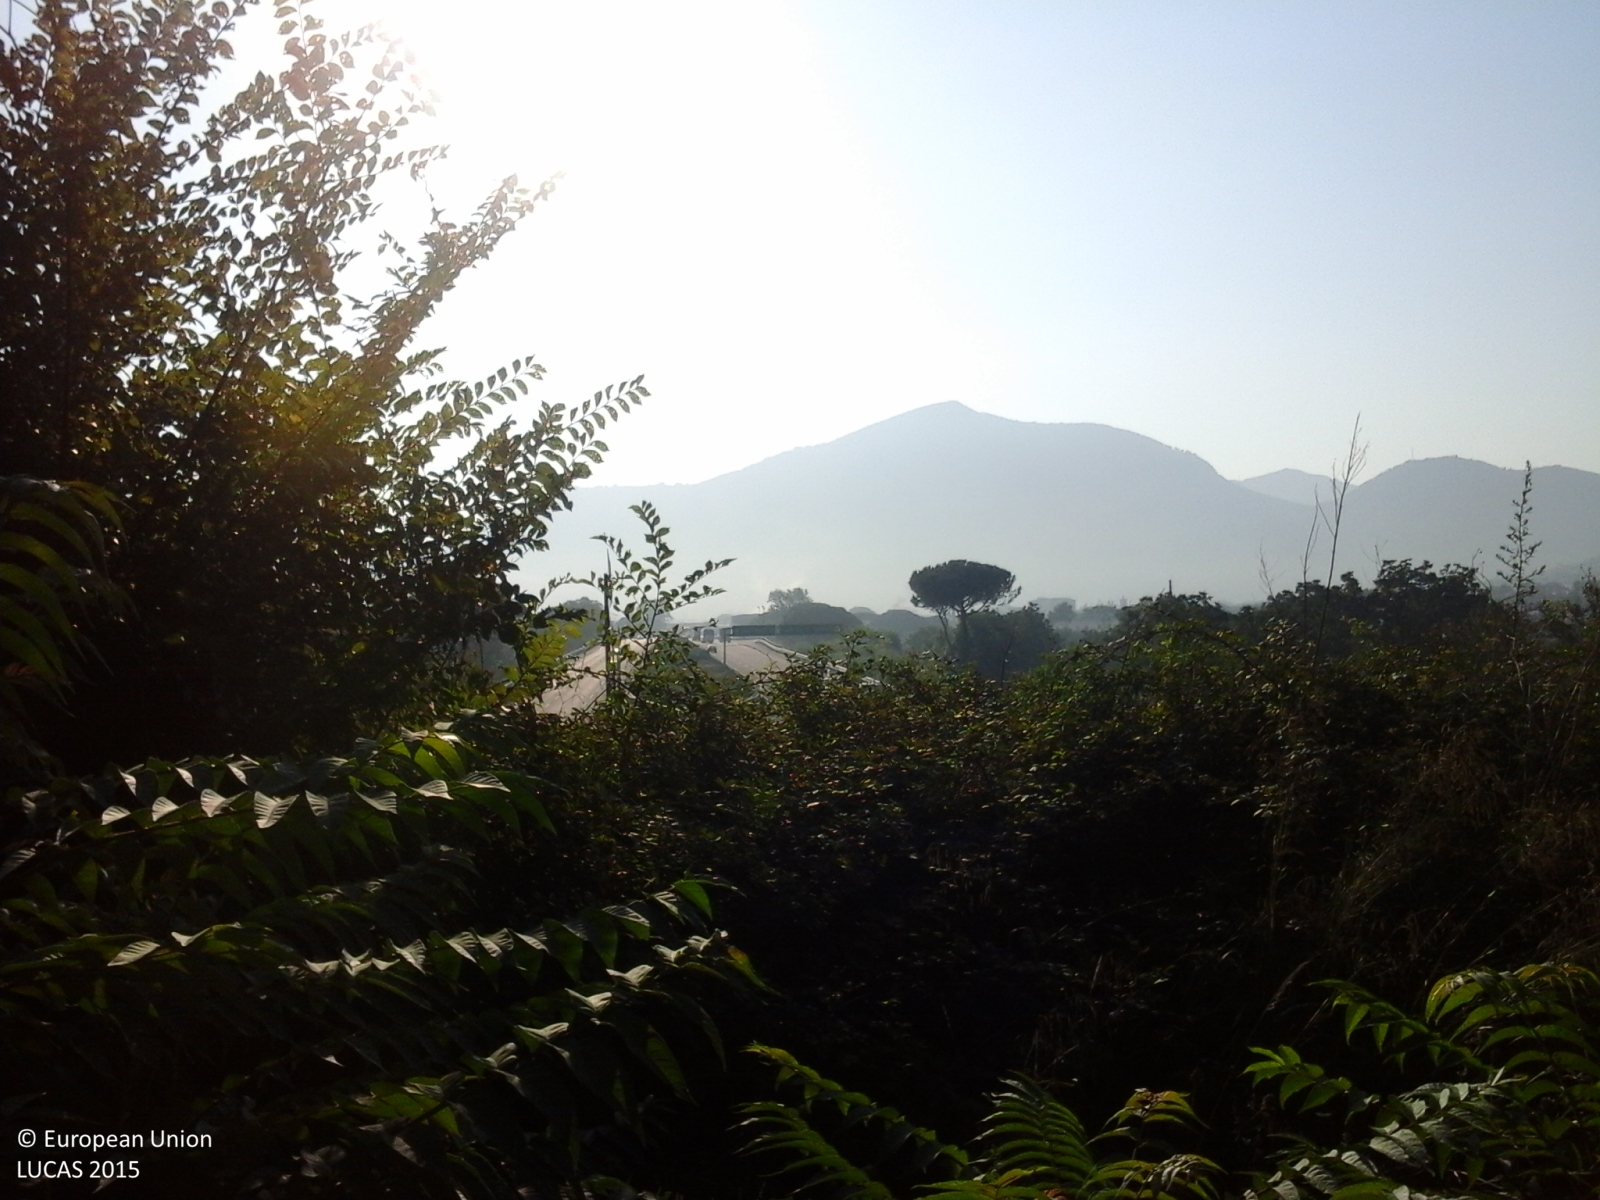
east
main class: Shrubland
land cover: Shrubland with sparse tree cover
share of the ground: > 75 %
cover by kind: shrubs 50 %, herbaceous plants 30 %, broadleaved forest trees 5 %
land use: Semi-natural and natural areas not in use
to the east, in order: Shrubland with sparse tree cover; Electric lines; Shrubland with sparse tree cover; Artificial constructions in urban areas; Permanent crops (only in case pi); Fences; Permanent crops (only in case pi); Artificial constructions in urban areas
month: September
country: IT
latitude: 40.7727
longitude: 14.6607
